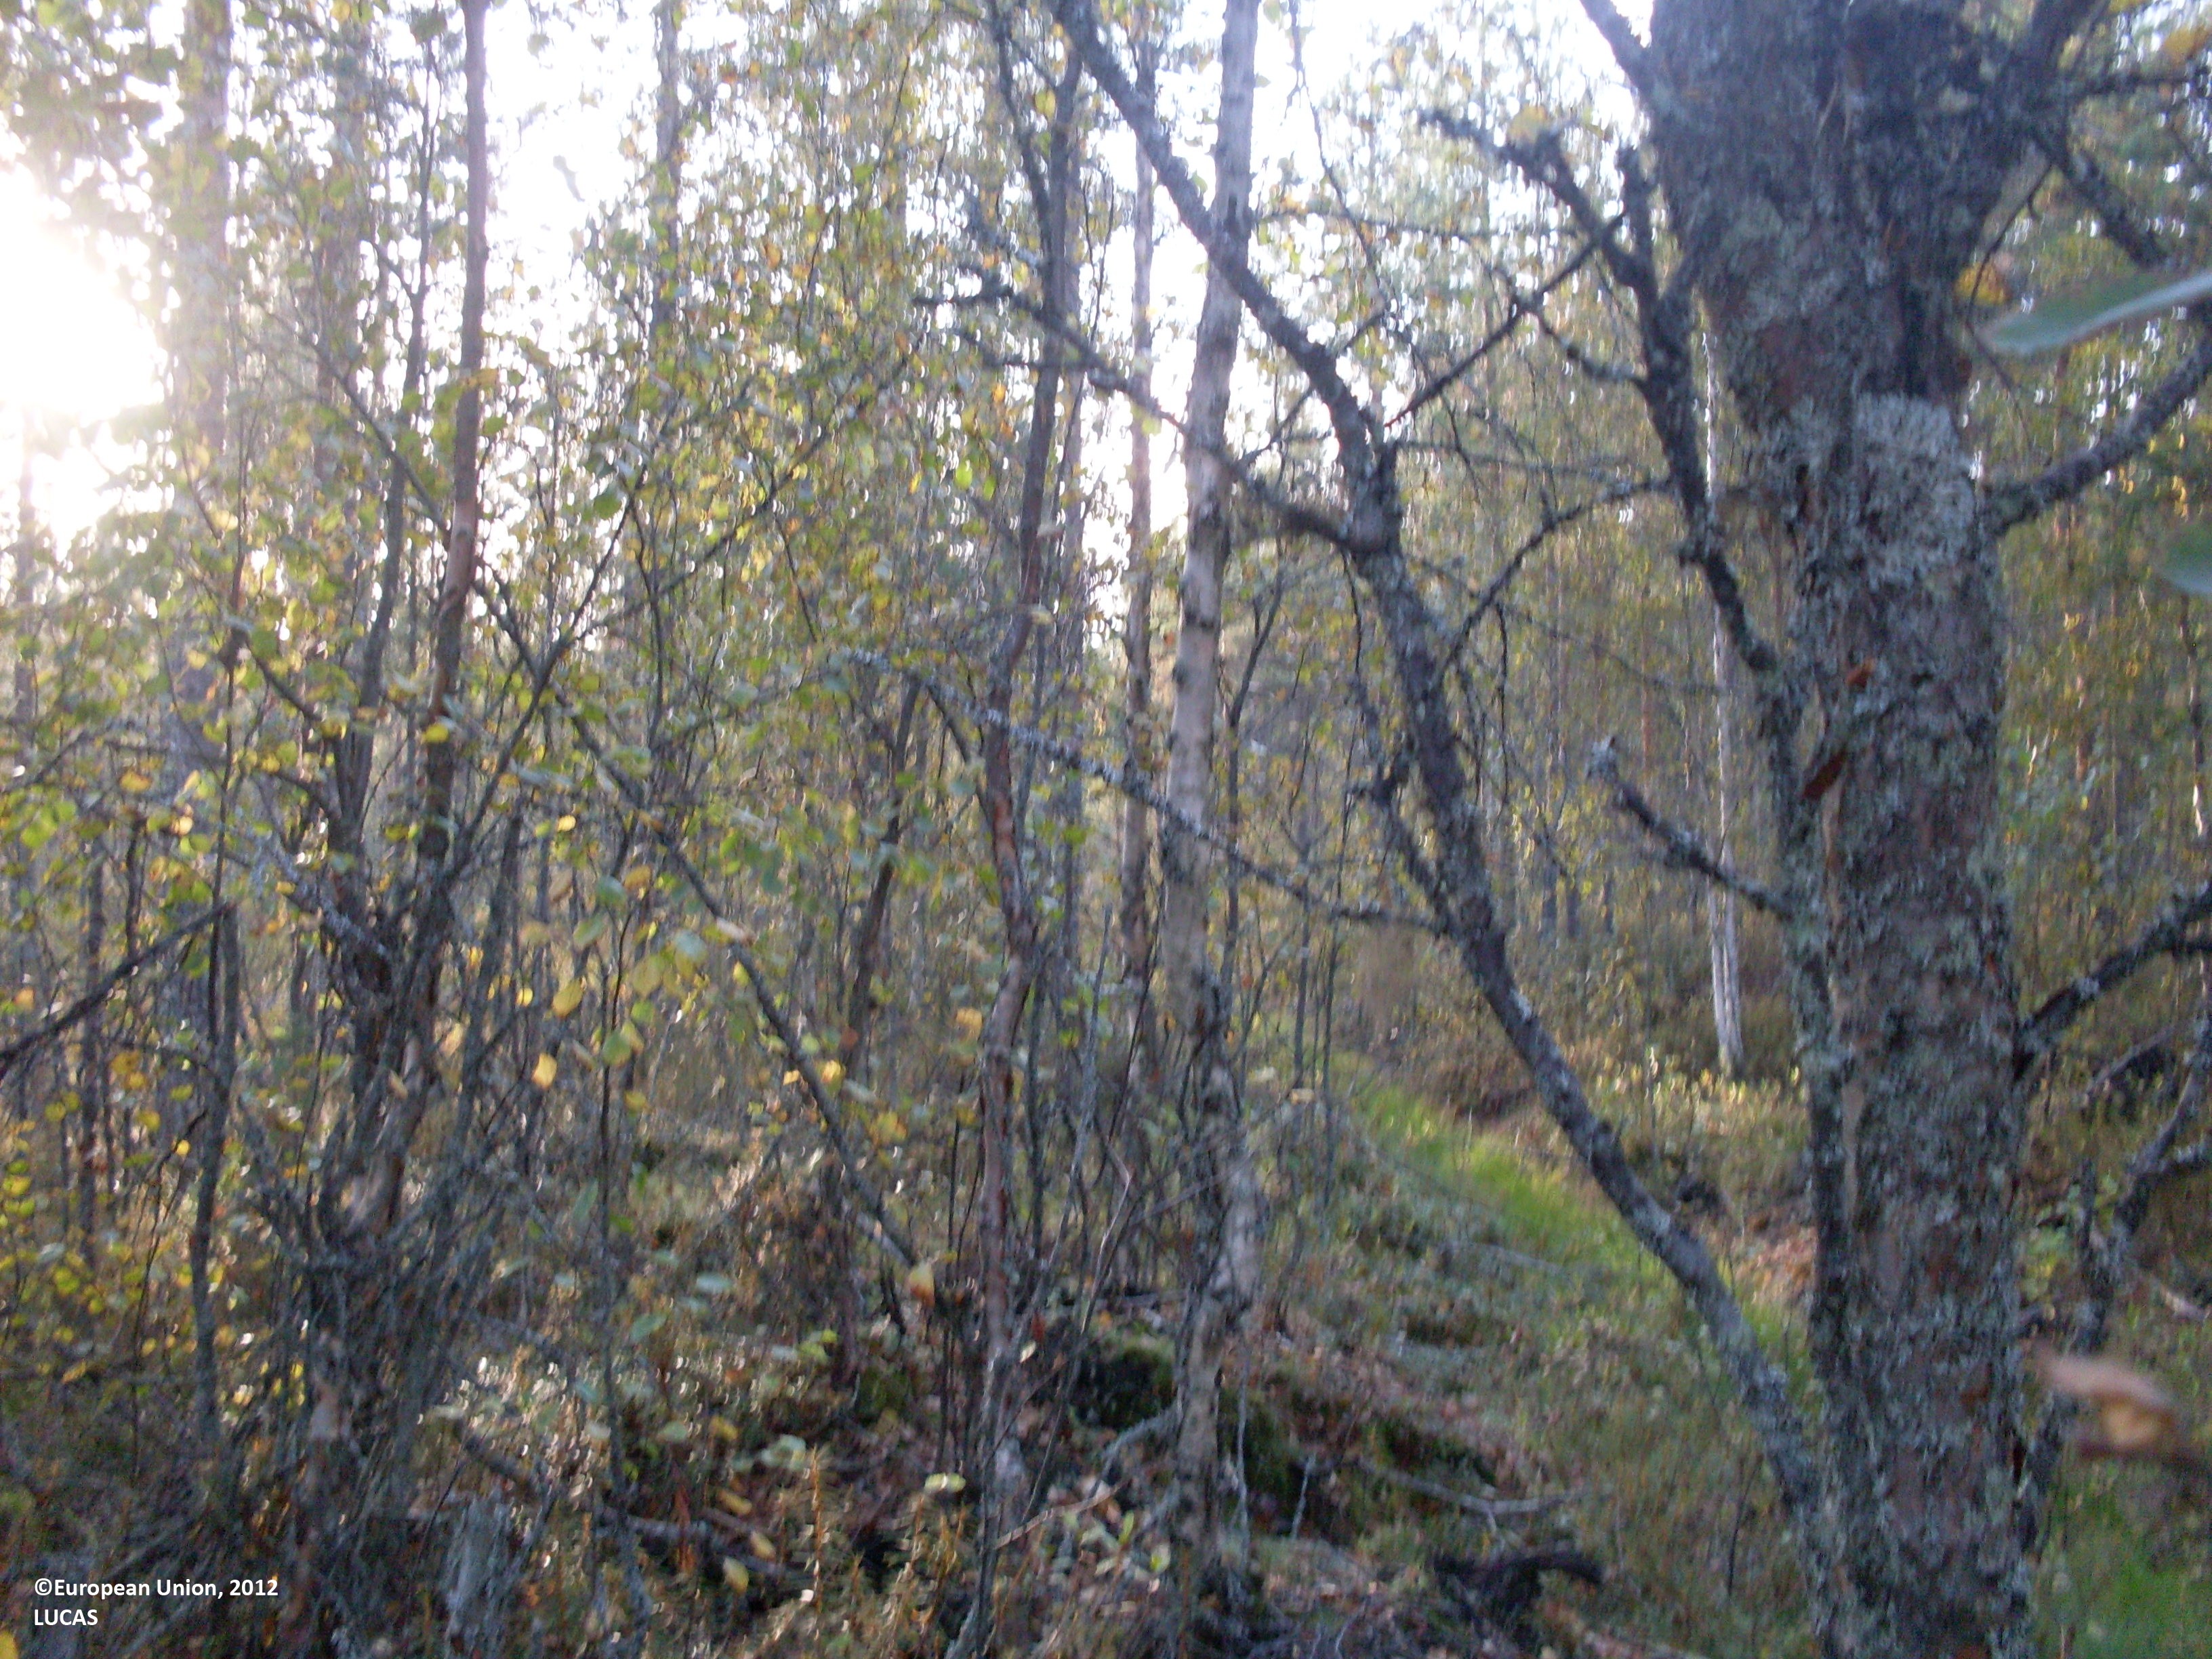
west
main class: Woodland
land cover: Pine dominated coniferous woodland
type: boreal forest
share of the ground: 50 - 75 %
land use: Forestry
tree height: > 5 m
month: September
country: FI
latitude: 64.0790
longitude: 29.2578
